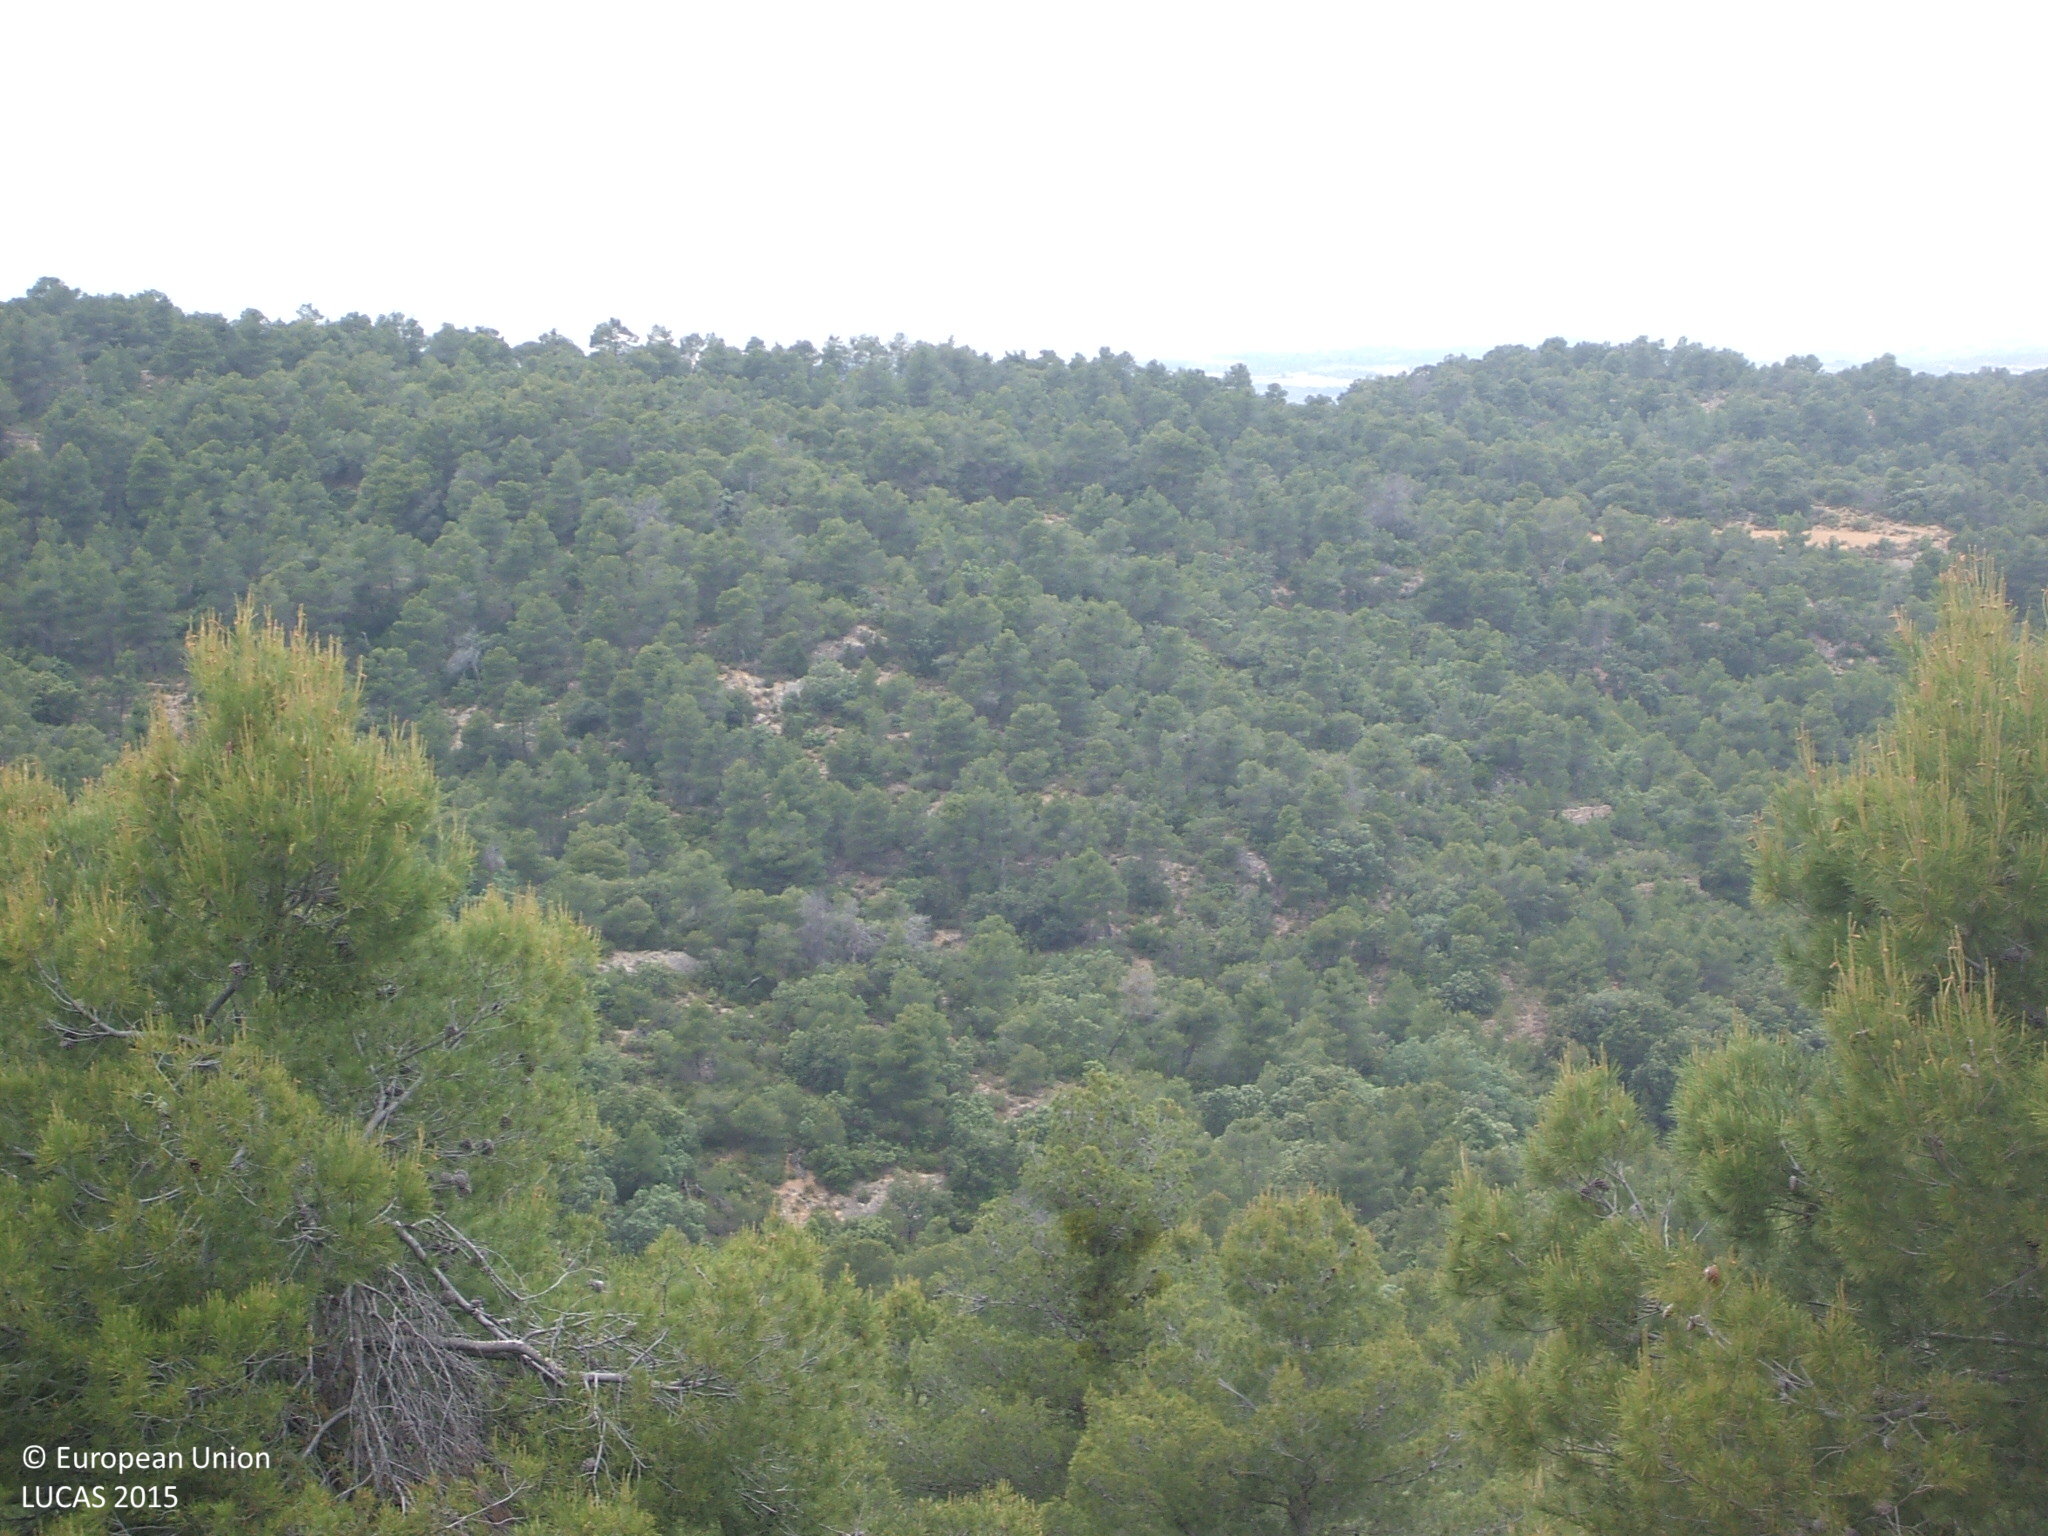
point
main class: Woodland
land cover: Pine dominated mixed woodland
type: coniferous forest of the mediterranean region
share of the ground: > 75 %
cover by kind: coniferous forest trees 75 %, broadleaved forest trees 25 %
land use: Semi-natural and natural areas not in use
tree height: > 5 m
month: June
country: ES
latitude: 40.8627
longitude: -0.0342
